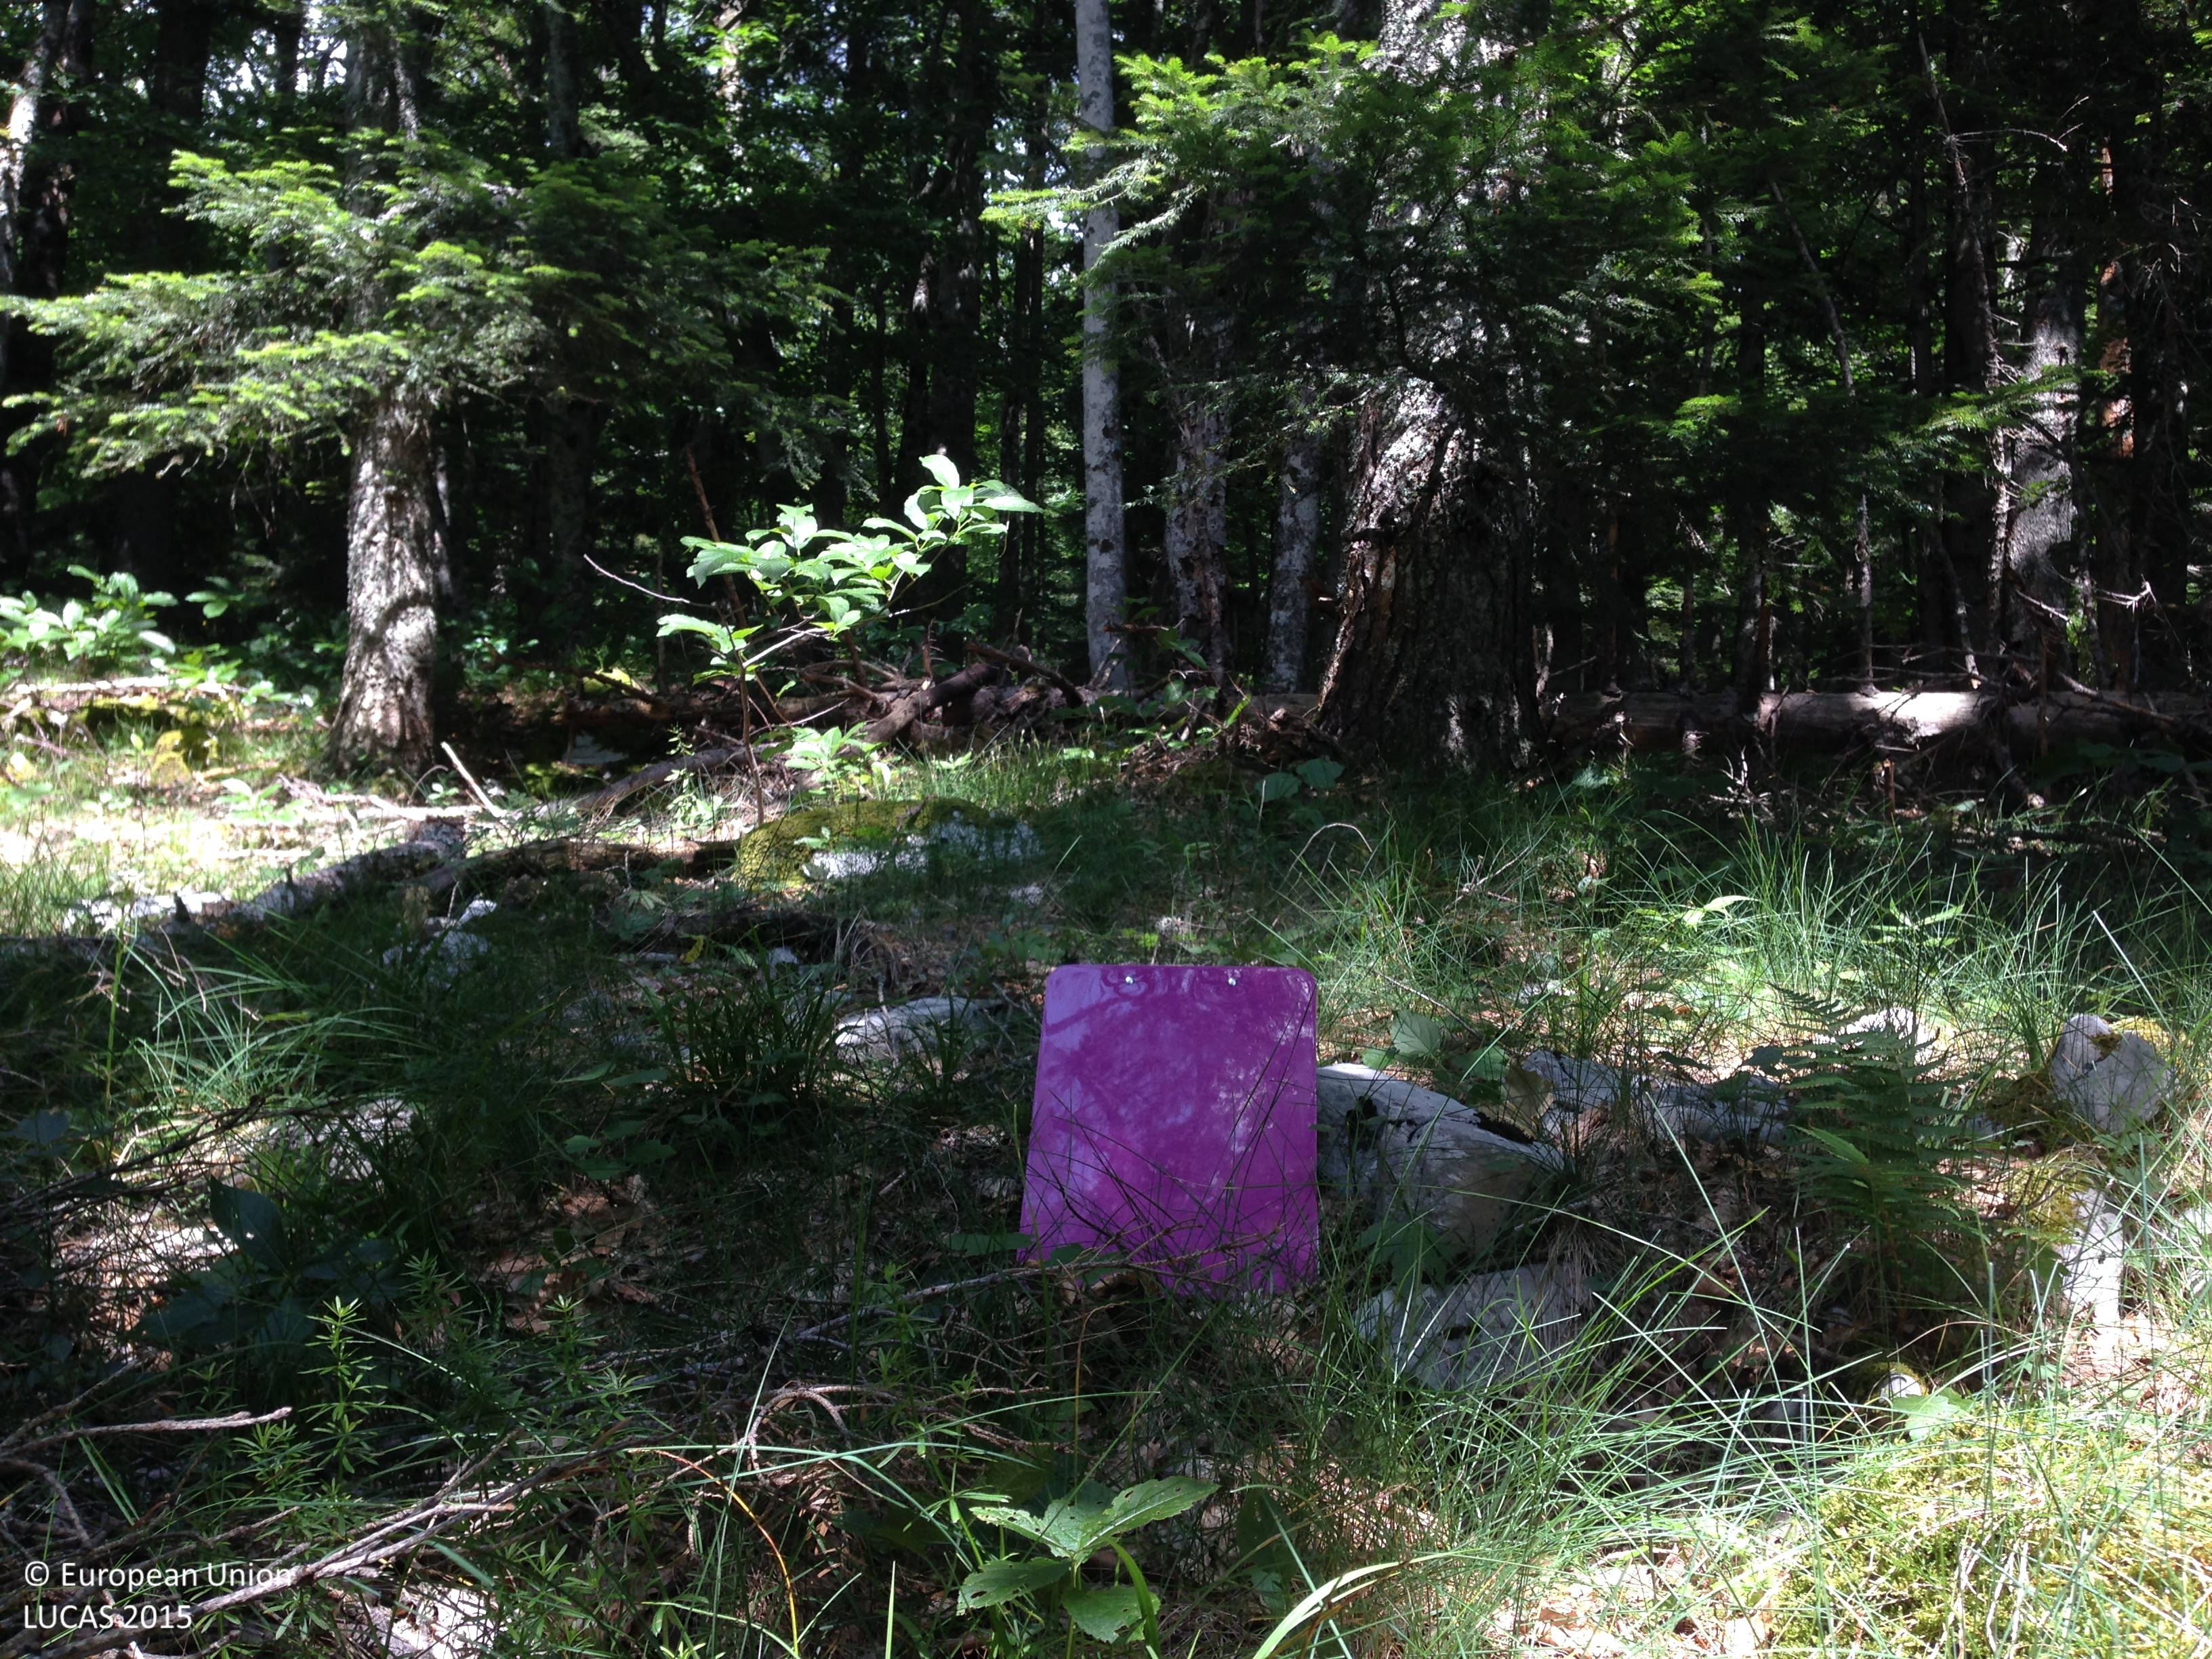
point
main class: Woodland
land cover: Other mixed woodland
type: mountainous beech forest
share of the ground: > 75 %
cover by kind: coniferous forest trees 40 %, broadleaved forest trees 30 %, herbaceous plants 20 %, shrubs 5 %, consolidated bare surface 5 %
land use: Forestry
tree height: > 5 m
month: June
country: HR
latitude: 44.7892
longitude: 15.7202
